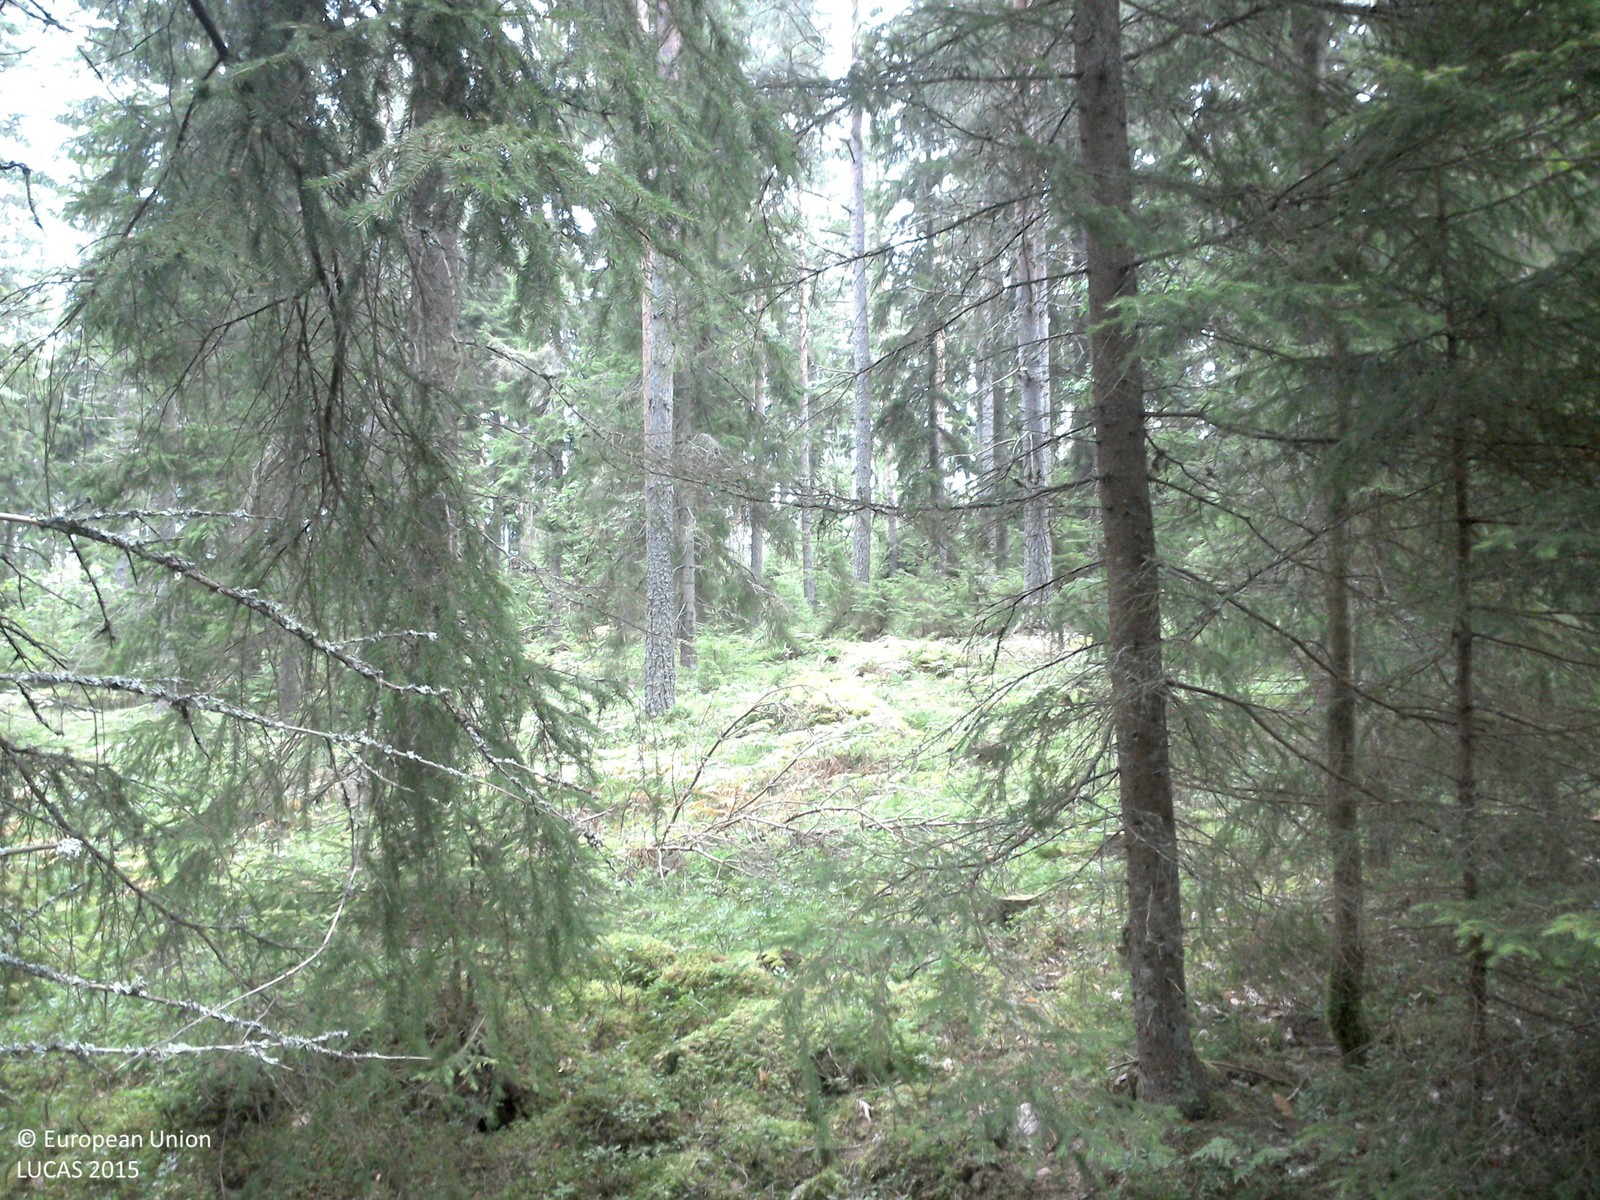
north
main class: Woodland
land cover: Pine dominated coniferous woodland
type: boreal forest
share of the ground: 25 - 50 %
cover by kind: coniferous forest trees 45 %, lichens and mosses 45 %, herbaceous plants 10 %
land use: Forestry
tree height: > 5 m
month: August
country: SE
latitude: 57.8113
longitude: 15.2300
